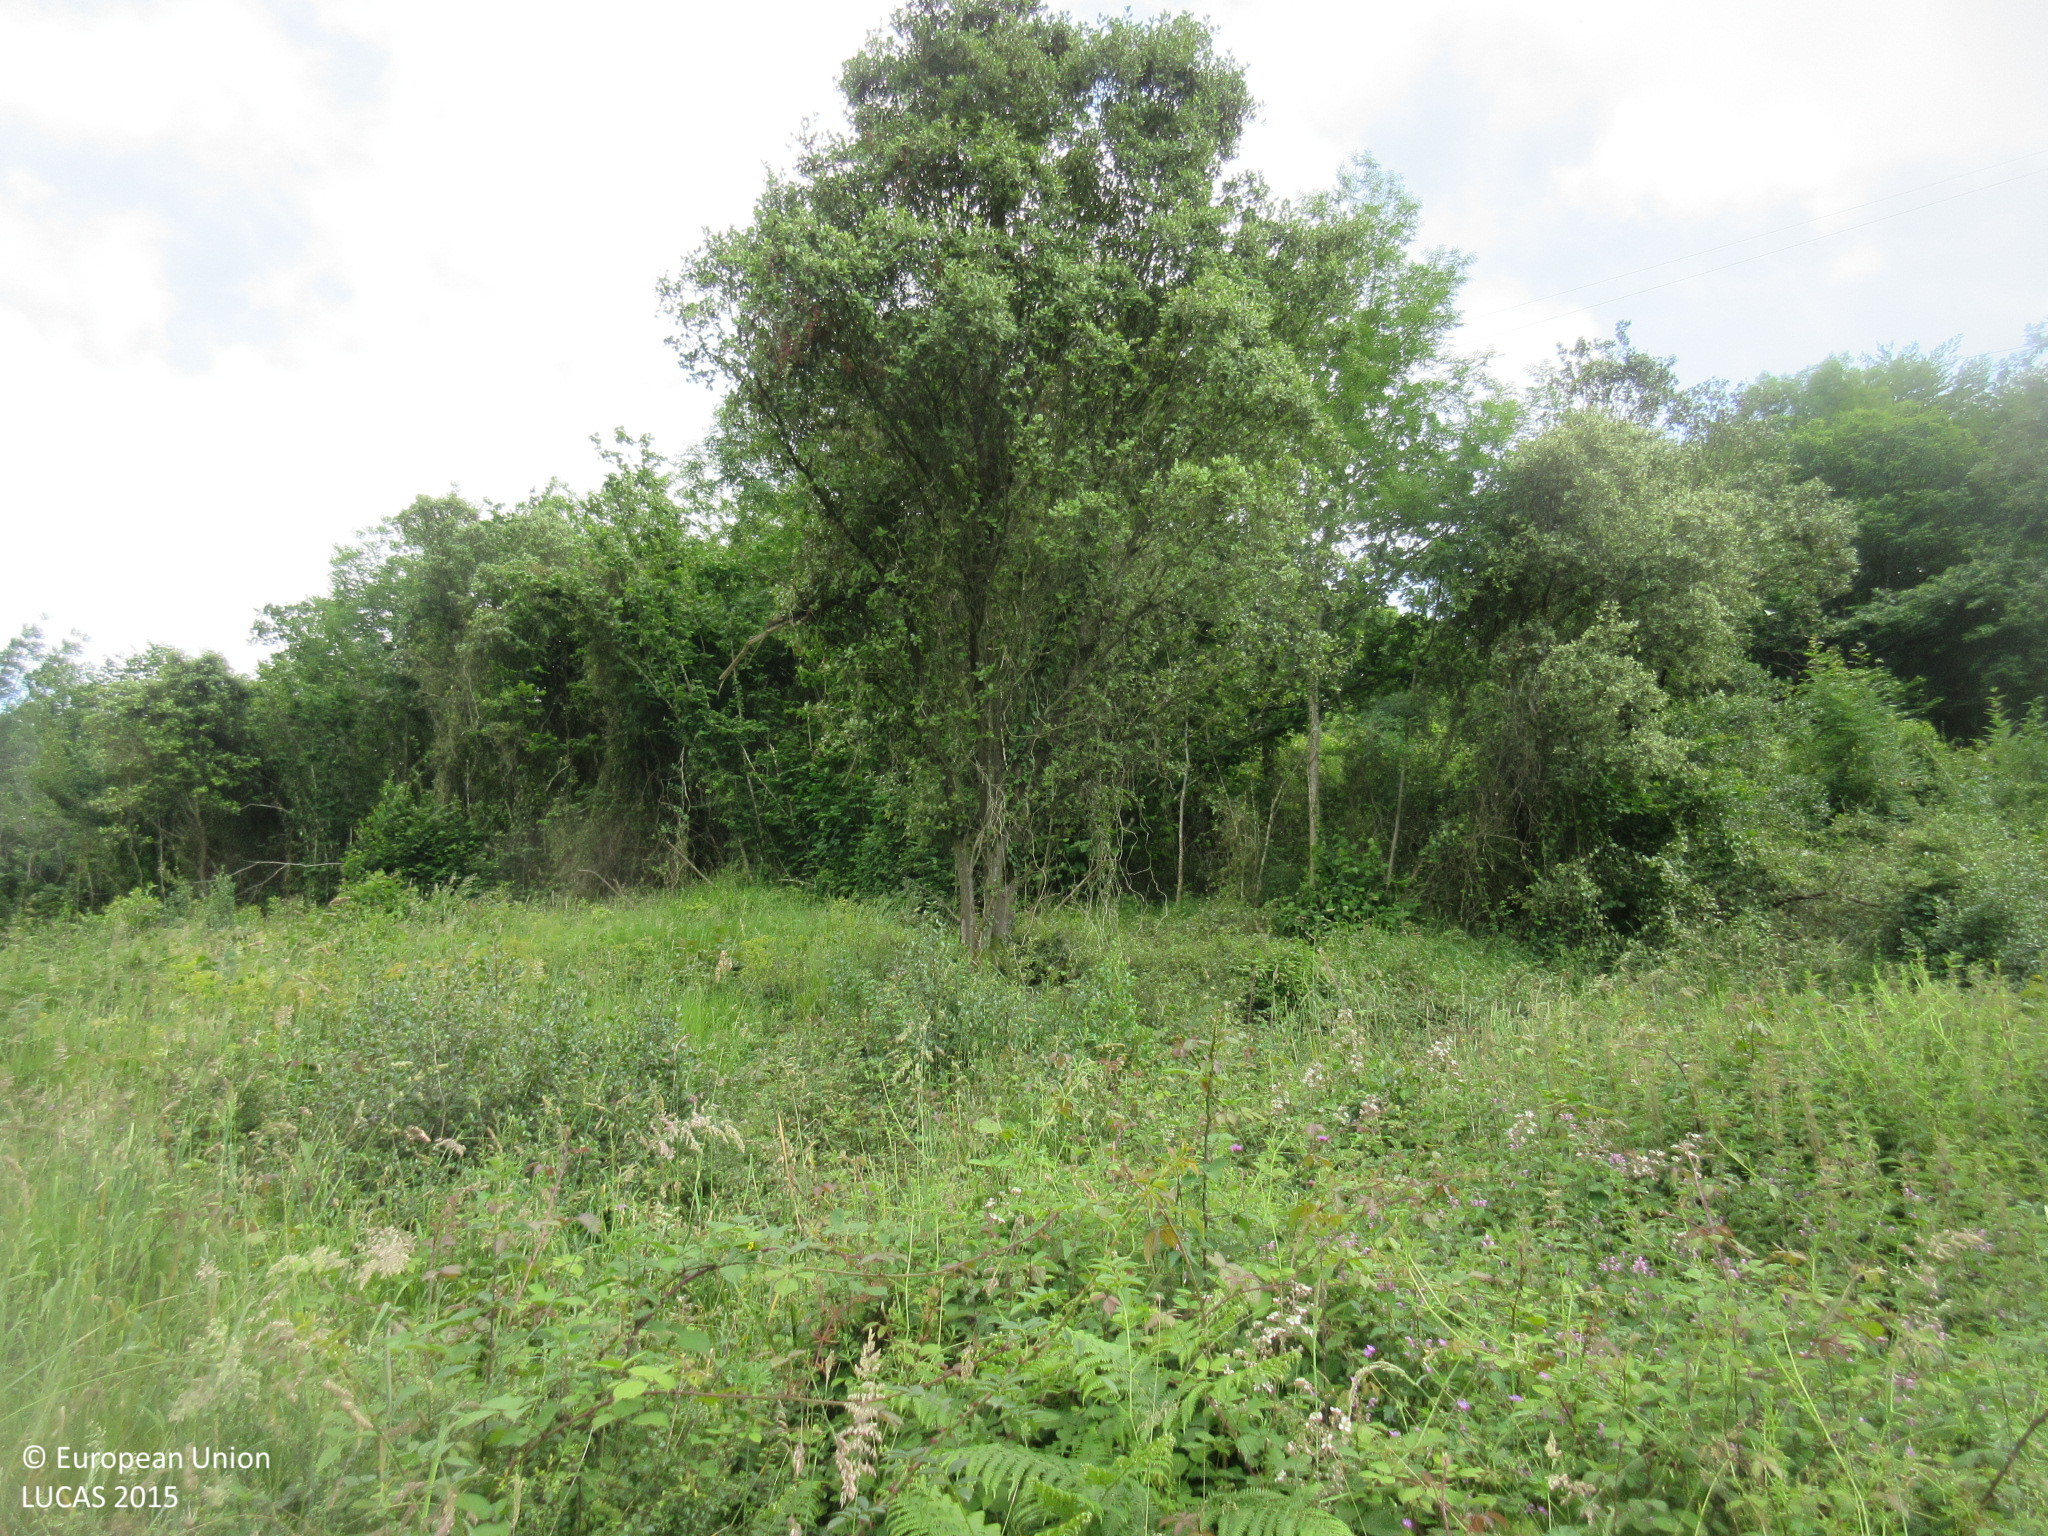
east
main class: Shrubland
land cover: Shrubland without tree cover
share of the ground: > 75 %
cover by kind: shrubs 90 %, herbaceous plants 10 %
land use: Agriculture (excluding fallow land and kitchen gardens)
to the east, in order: Shrubland without tree cover; Electric lines; Shrubland without tree cover; Broadleaved woodland; Dry stone walls; Grassland without tree/shrub cover; Dry stone walls; Groves
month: June
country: ES
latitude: 43.2868
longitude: -5.9756
